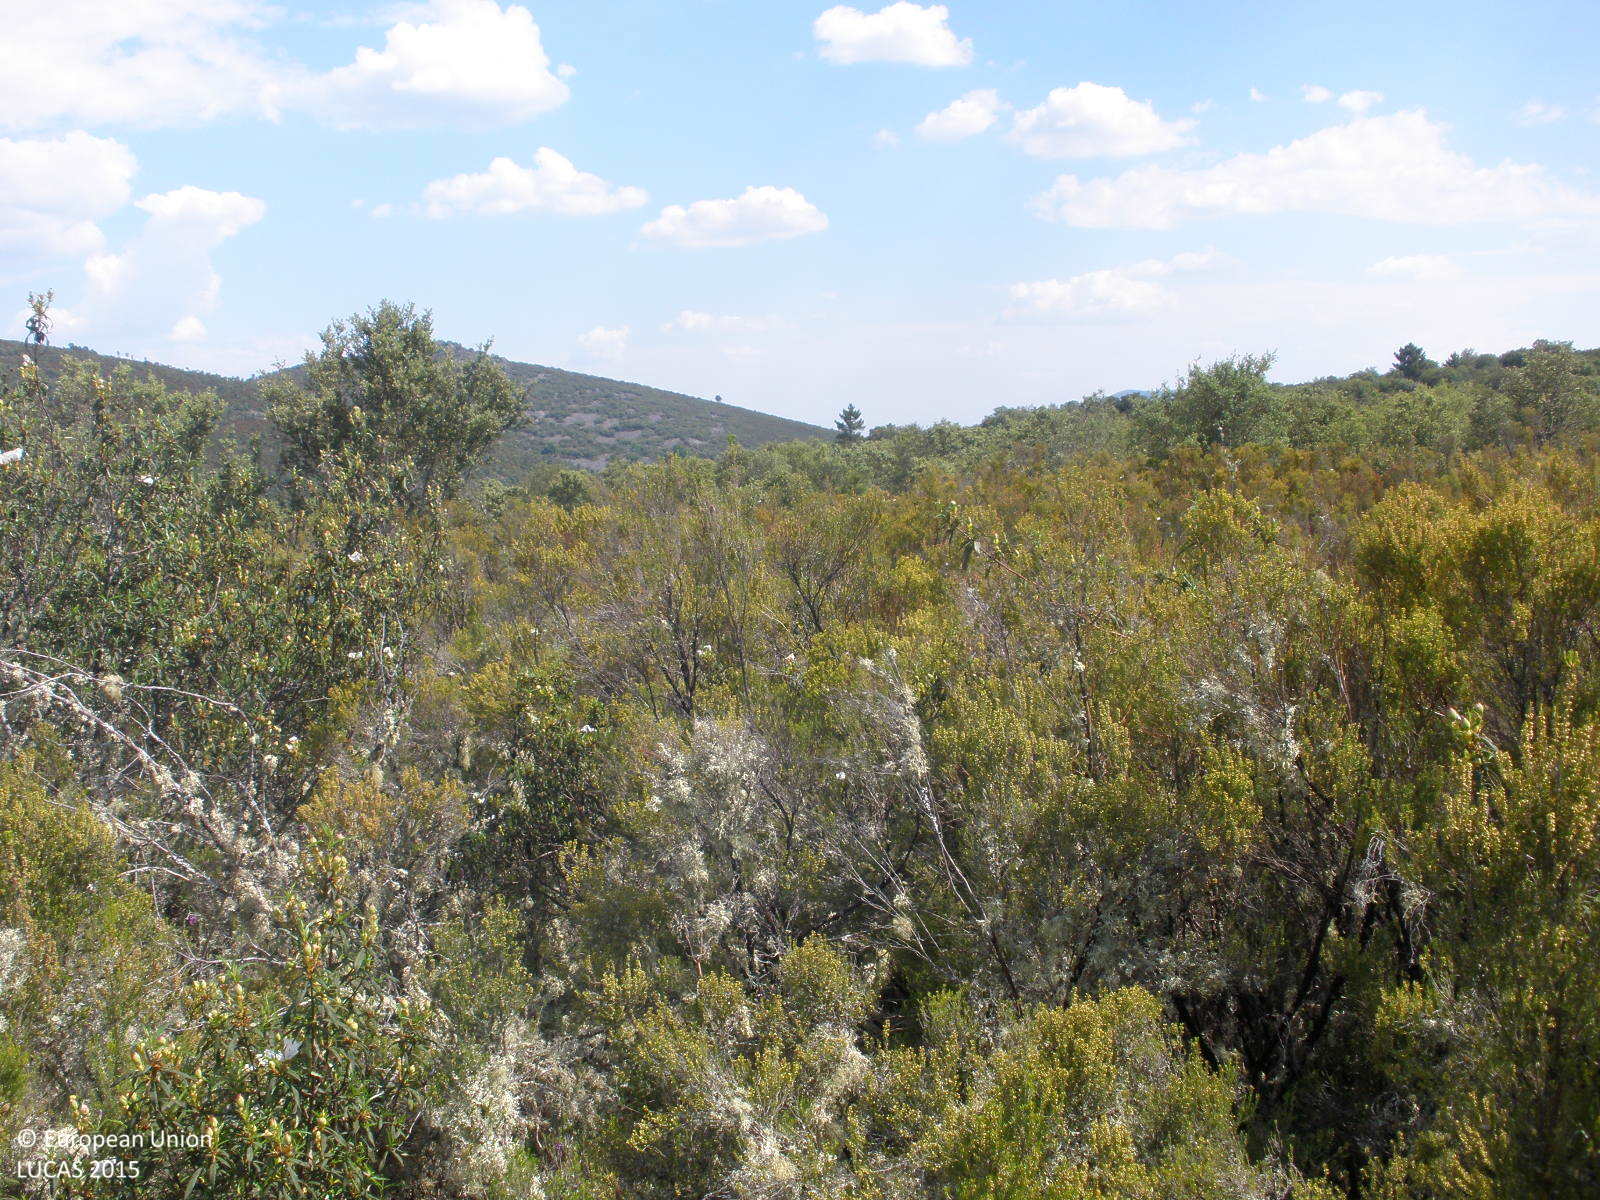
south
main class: Shrubland
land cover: Shrubland with sparse tree cover
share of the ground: > 75 %
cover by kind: shrubs 95 %, broadleaved forest trees 5 %
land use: Semi-natural and natural areas not in use
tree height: < 5 m
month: June
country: ES
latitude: 40.5433
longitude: -6.3436
